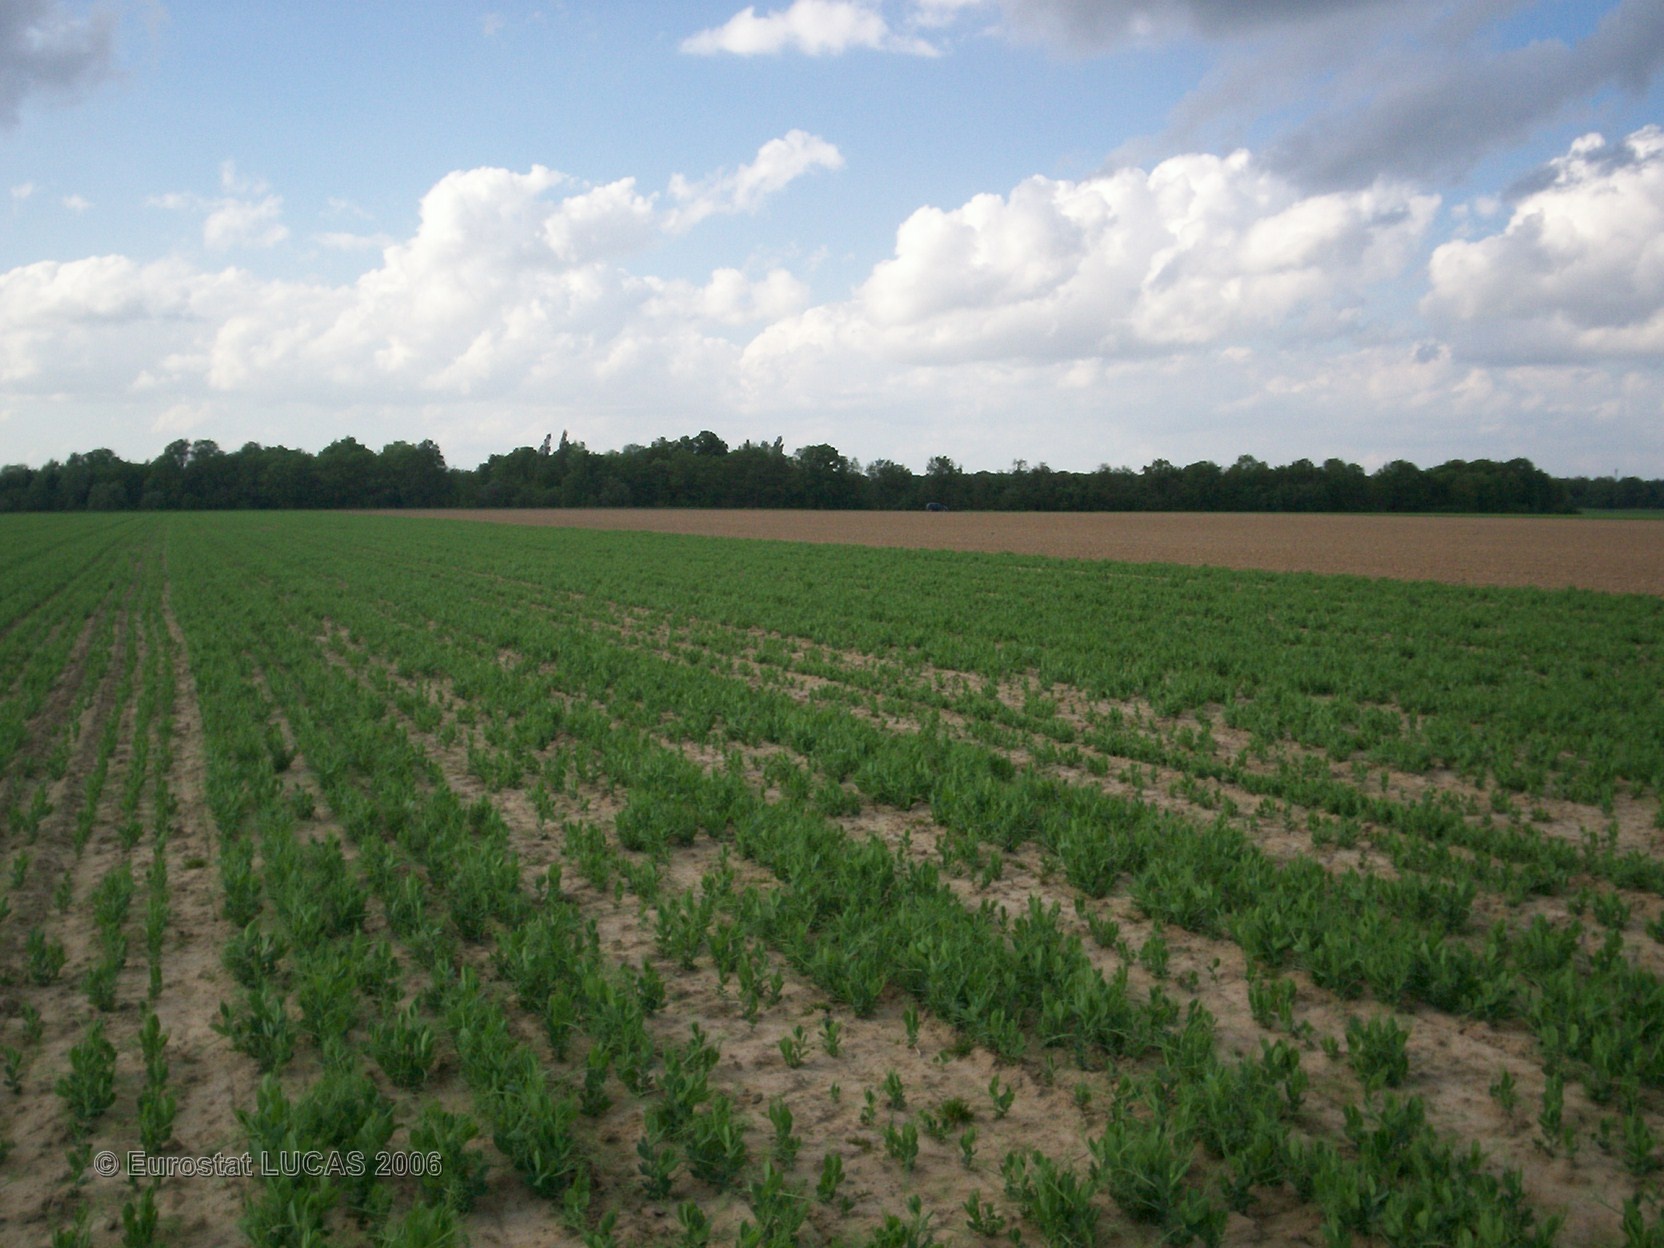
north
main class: Cropland
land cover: Dry pulses
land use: Agriculture (excluding fallow land and kitchen gardens)
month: May
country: FR
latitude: 48.7464
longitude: 2.7962
